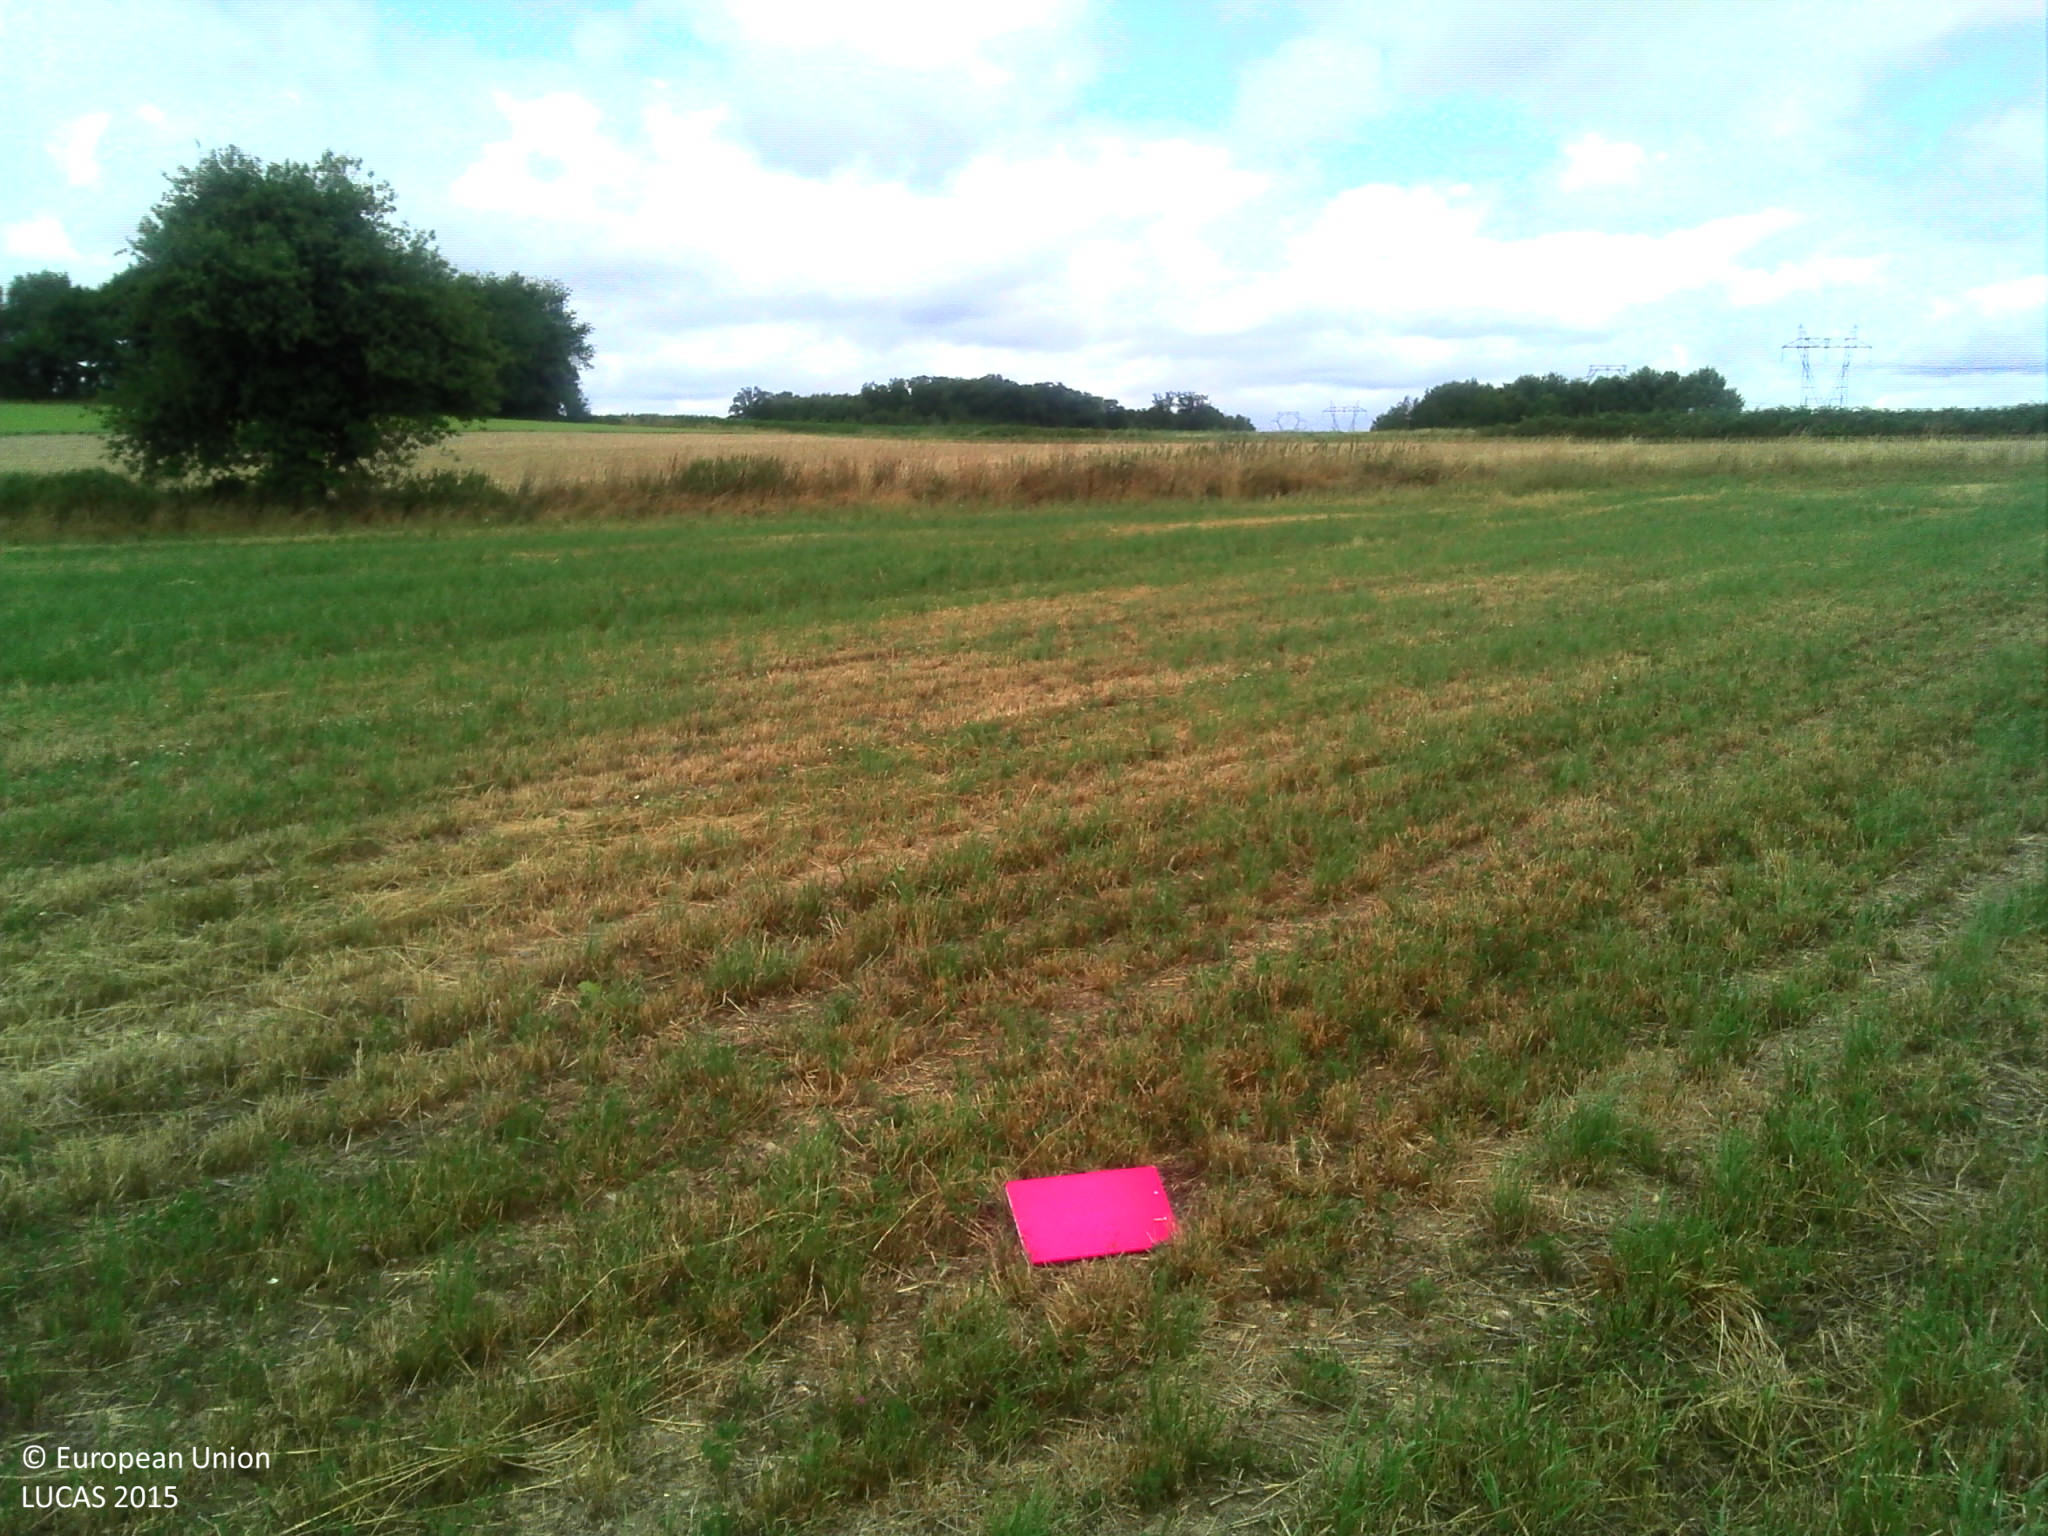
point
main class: Cropland
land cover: Temporary grasslands
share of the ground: > 75 %
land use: Agriculture (excluding fallow land and kitchen gardens)
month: July
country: FR
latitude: 46.3490
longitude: 1.6357
